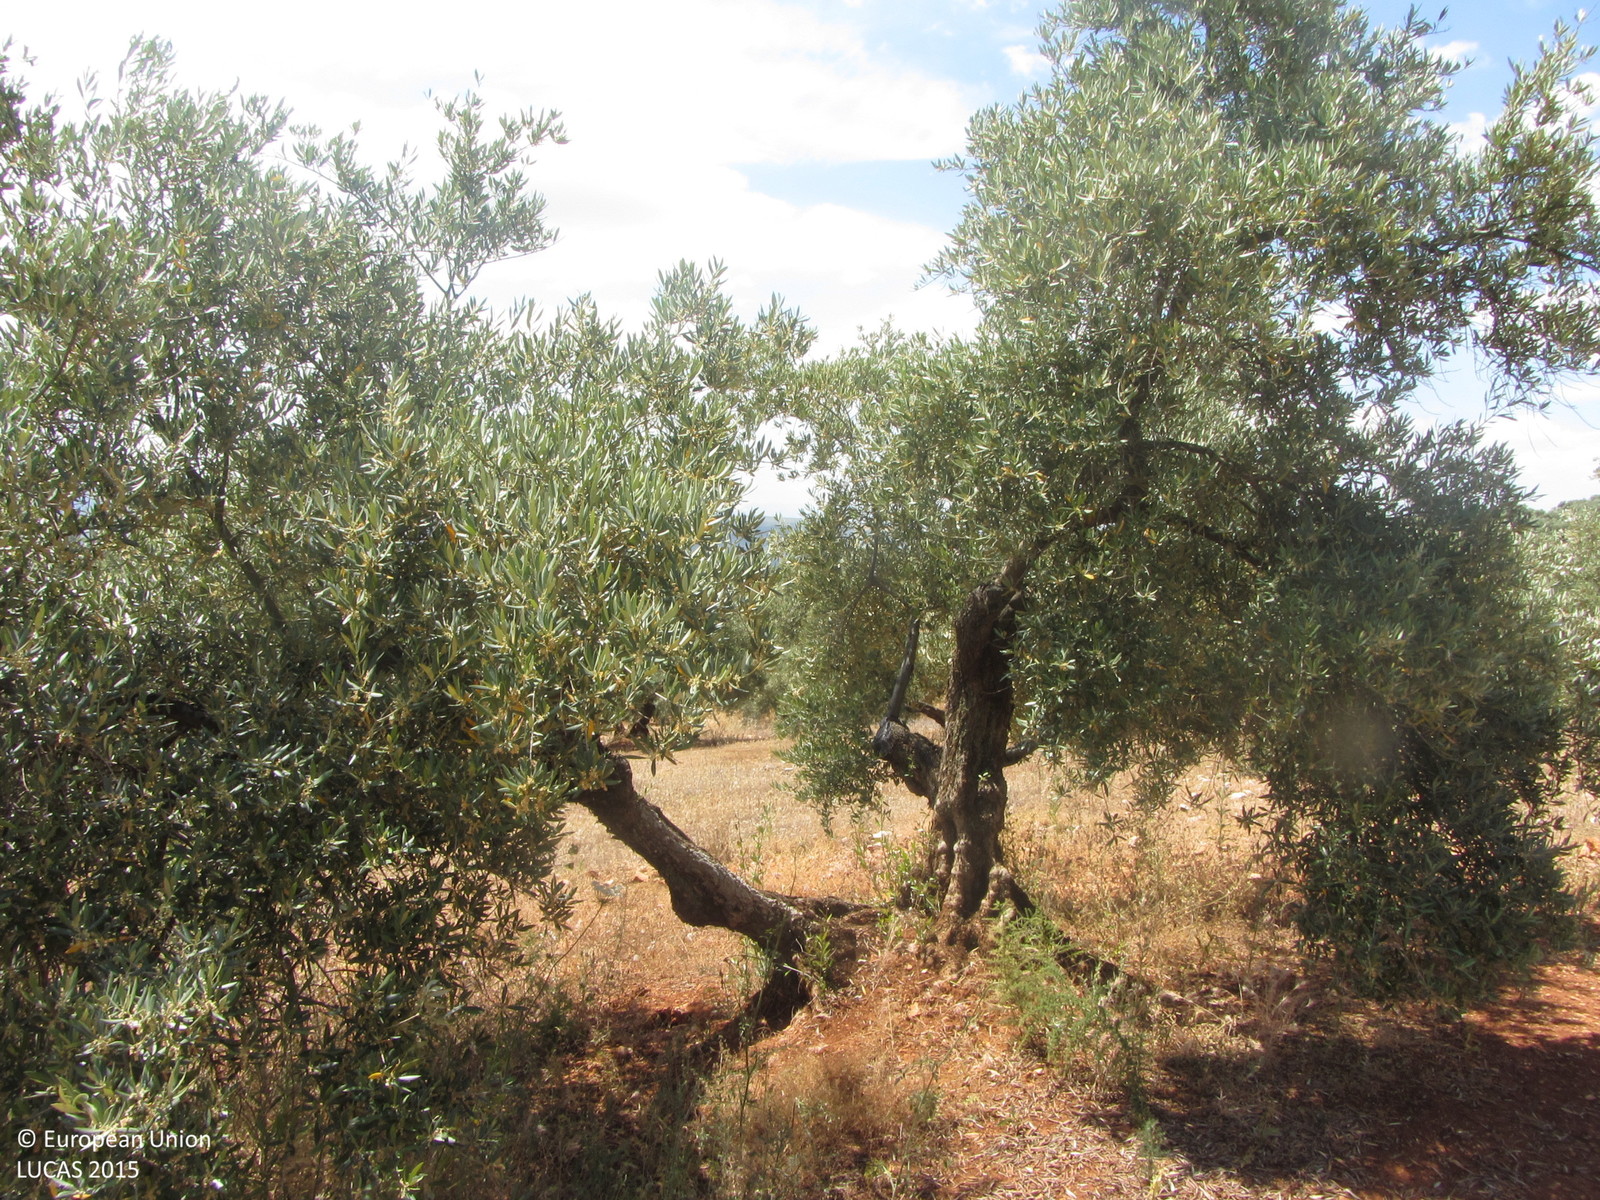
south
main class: Cropland
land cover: Olive groves
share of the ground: 25 - 50 %
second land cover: Spontaneously vegetated surfaces
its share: > 75 %
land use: Agriculture (excluding fallow land and kitchen gardens)
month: May
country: ES
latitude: 38.1665
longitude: -3.2987
